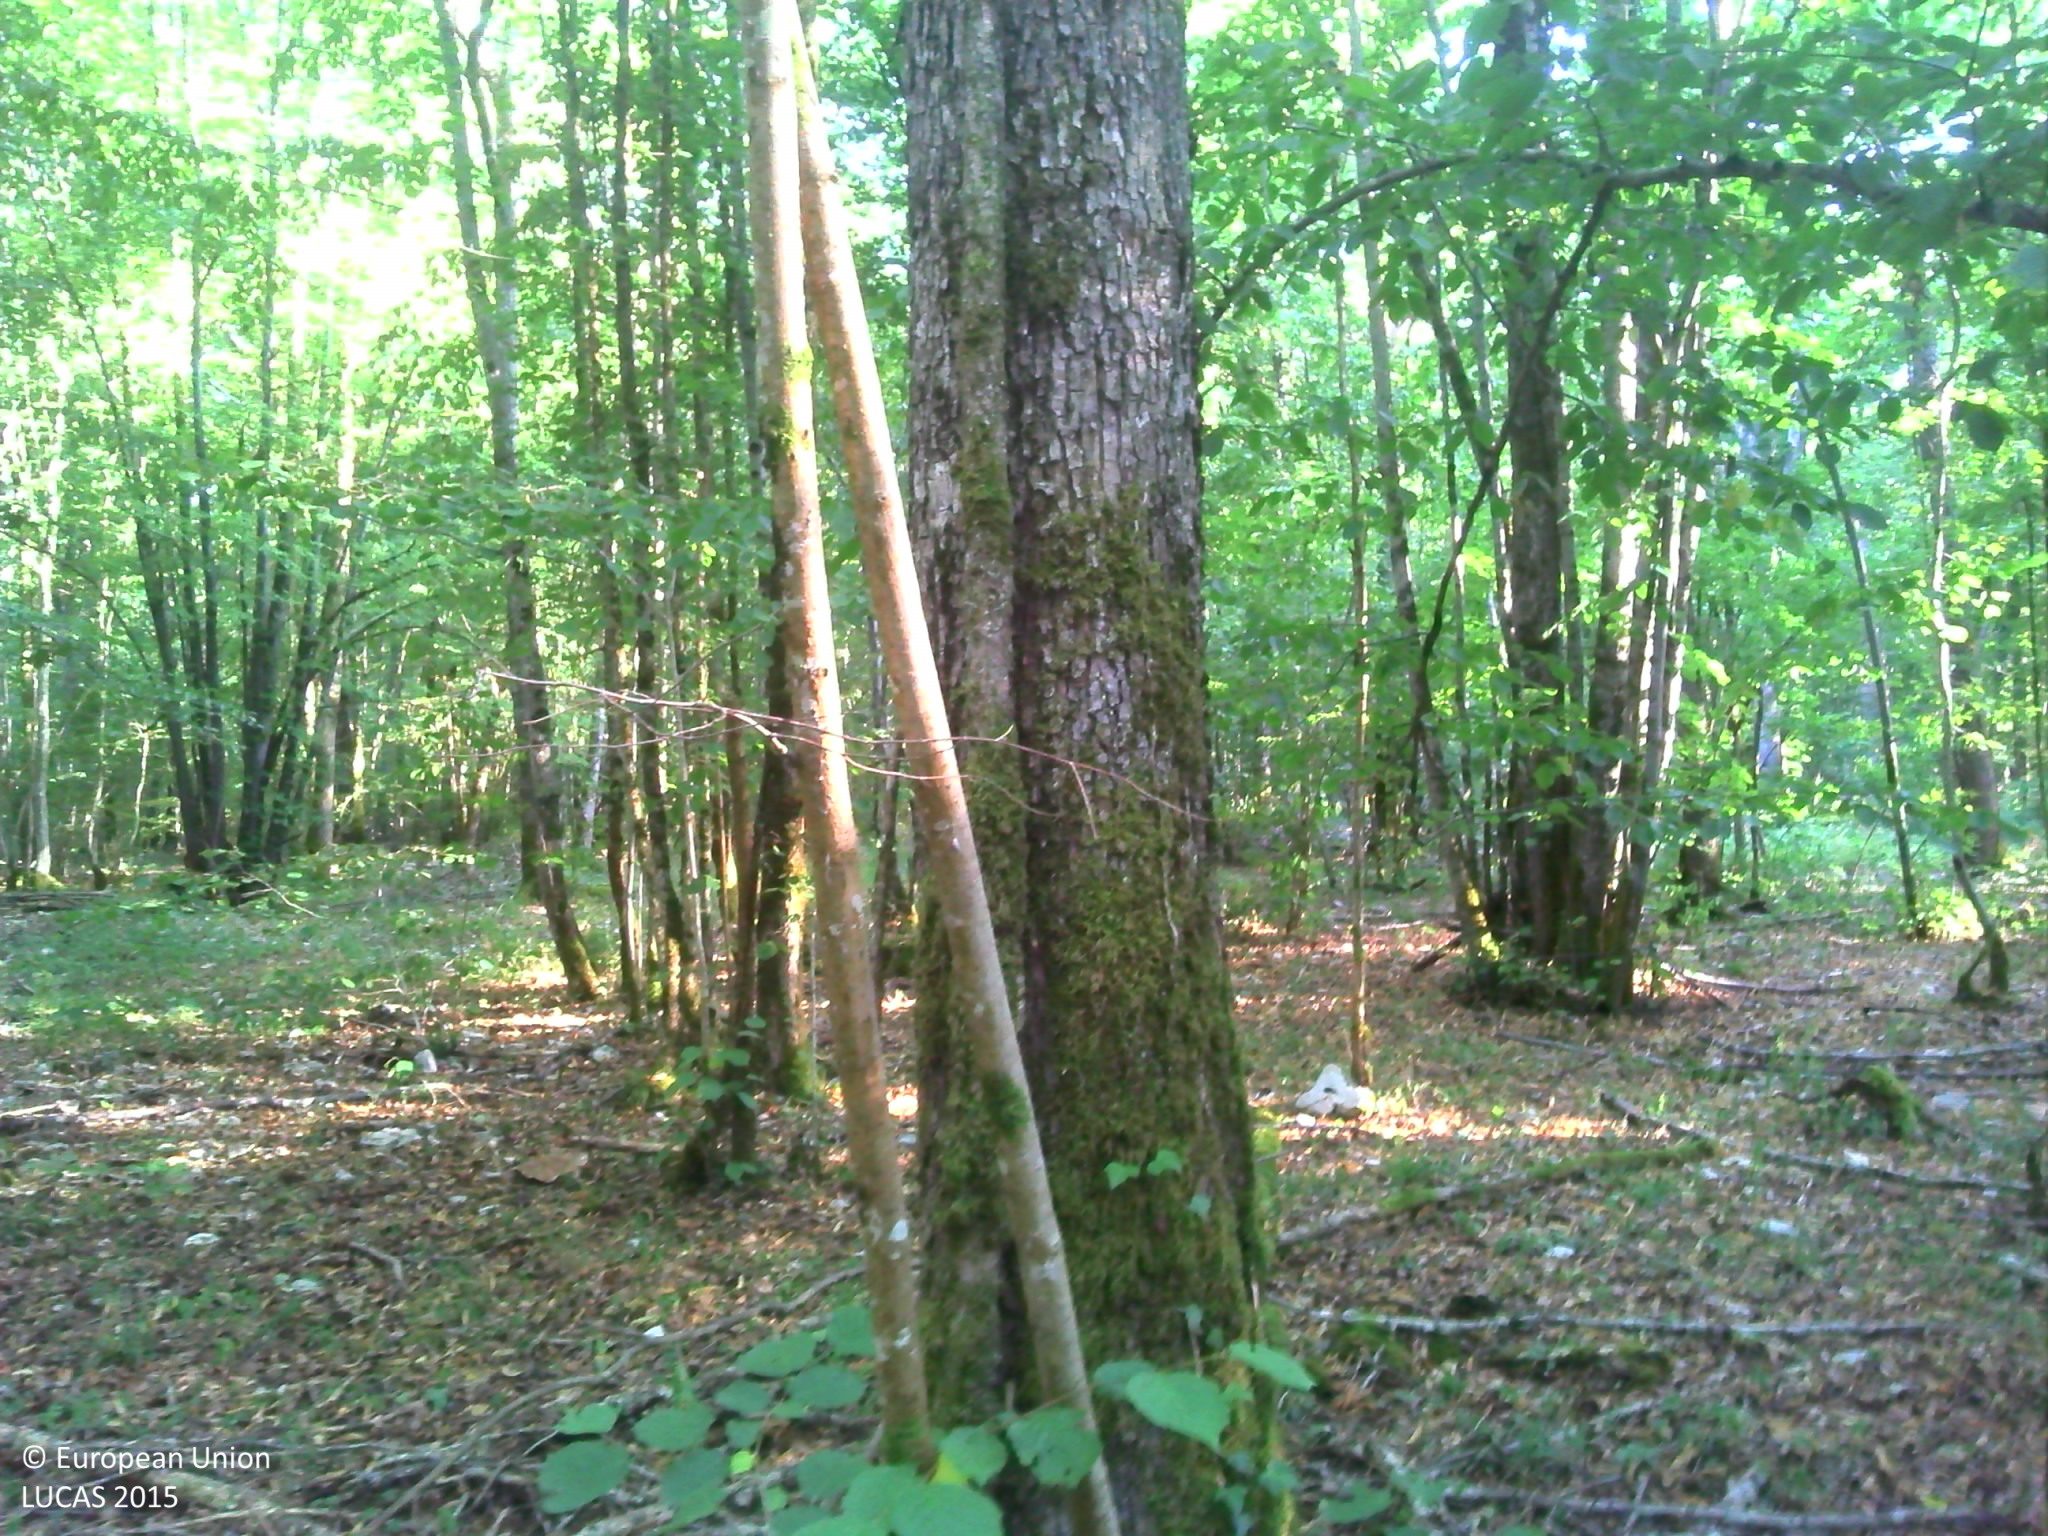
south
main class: Woodland
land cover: Broadleaved woodland
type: acidophilous oak and oak-birch forest
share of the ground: > 75 %
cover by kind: broadleaved forest trees 85 %, lichens and mosses 10 %, herbaceous plants 5 %
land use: Forestry
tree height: > 5 m
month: July
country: FR
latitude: 47.8726
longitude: 4.9321
